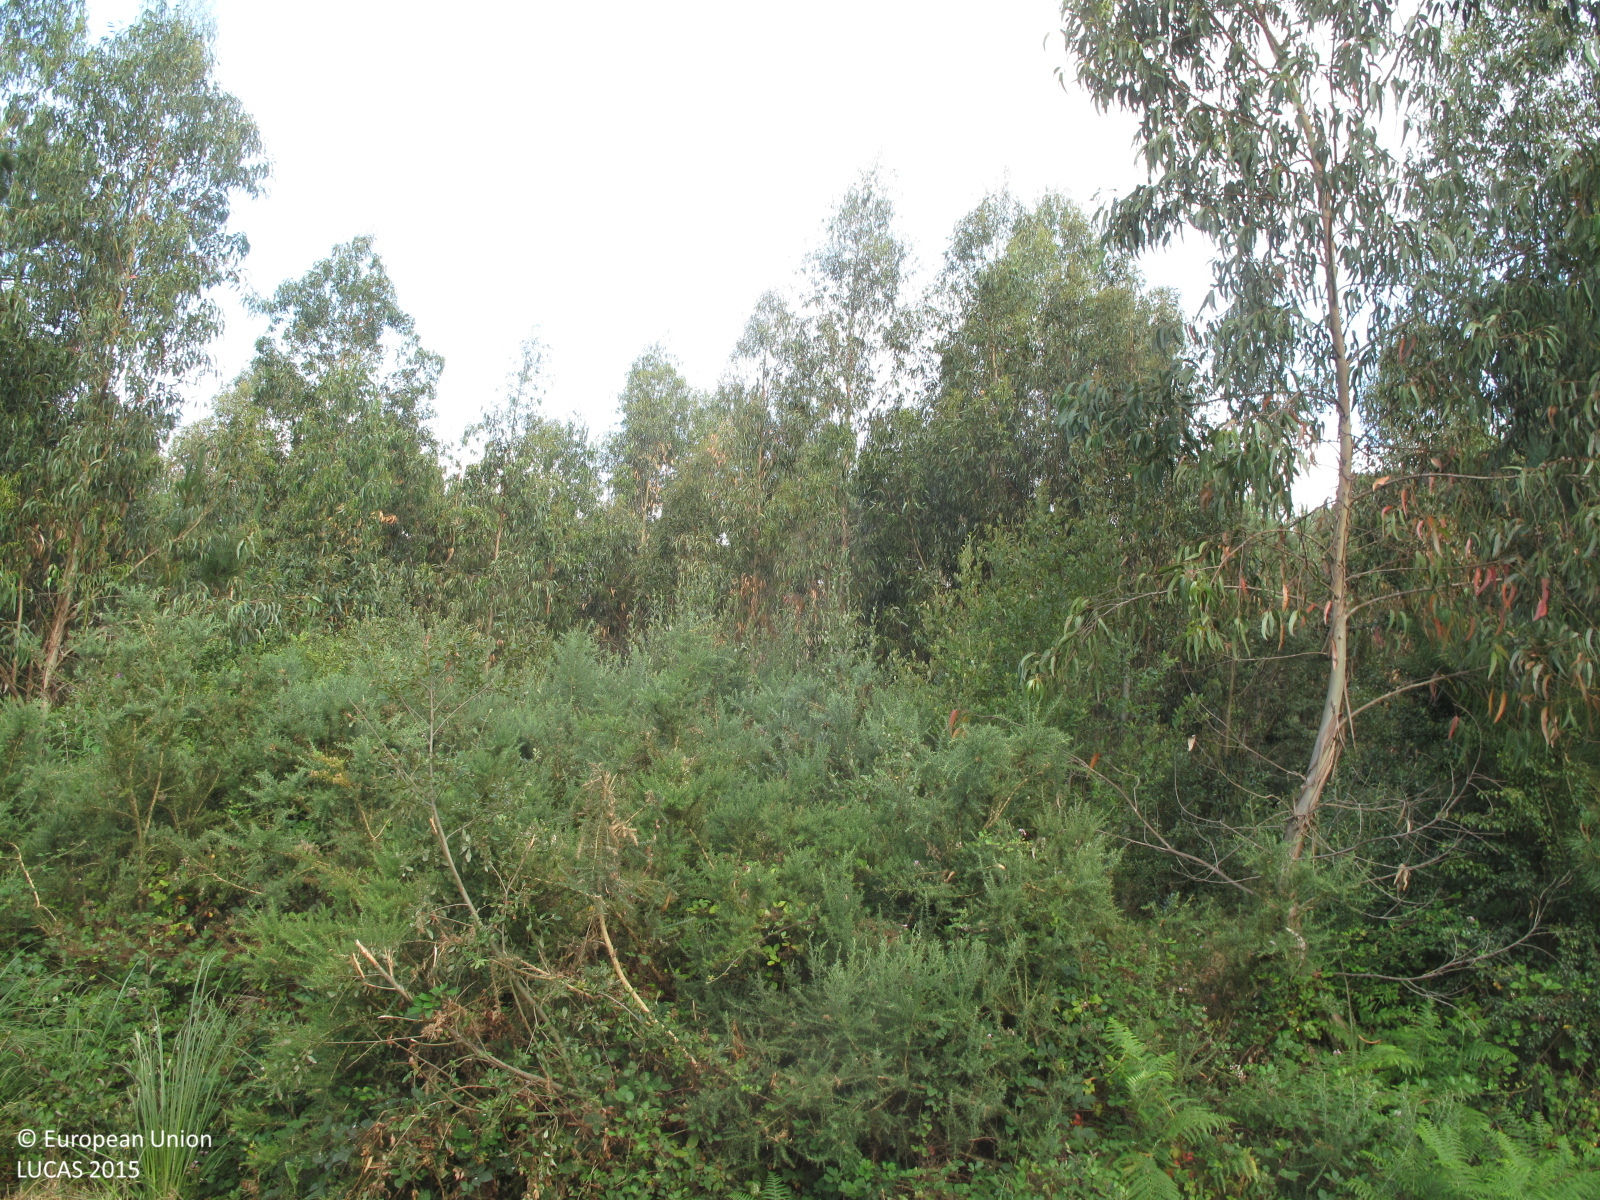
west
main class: Shrubland
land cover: Shrubland without tree cover
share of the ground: 50 - 75 %
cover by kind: shrubs 60 %, herbaceous plants 40 %
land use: Road transport
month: July
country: ES
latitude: 43.3693
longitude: -8.3066
